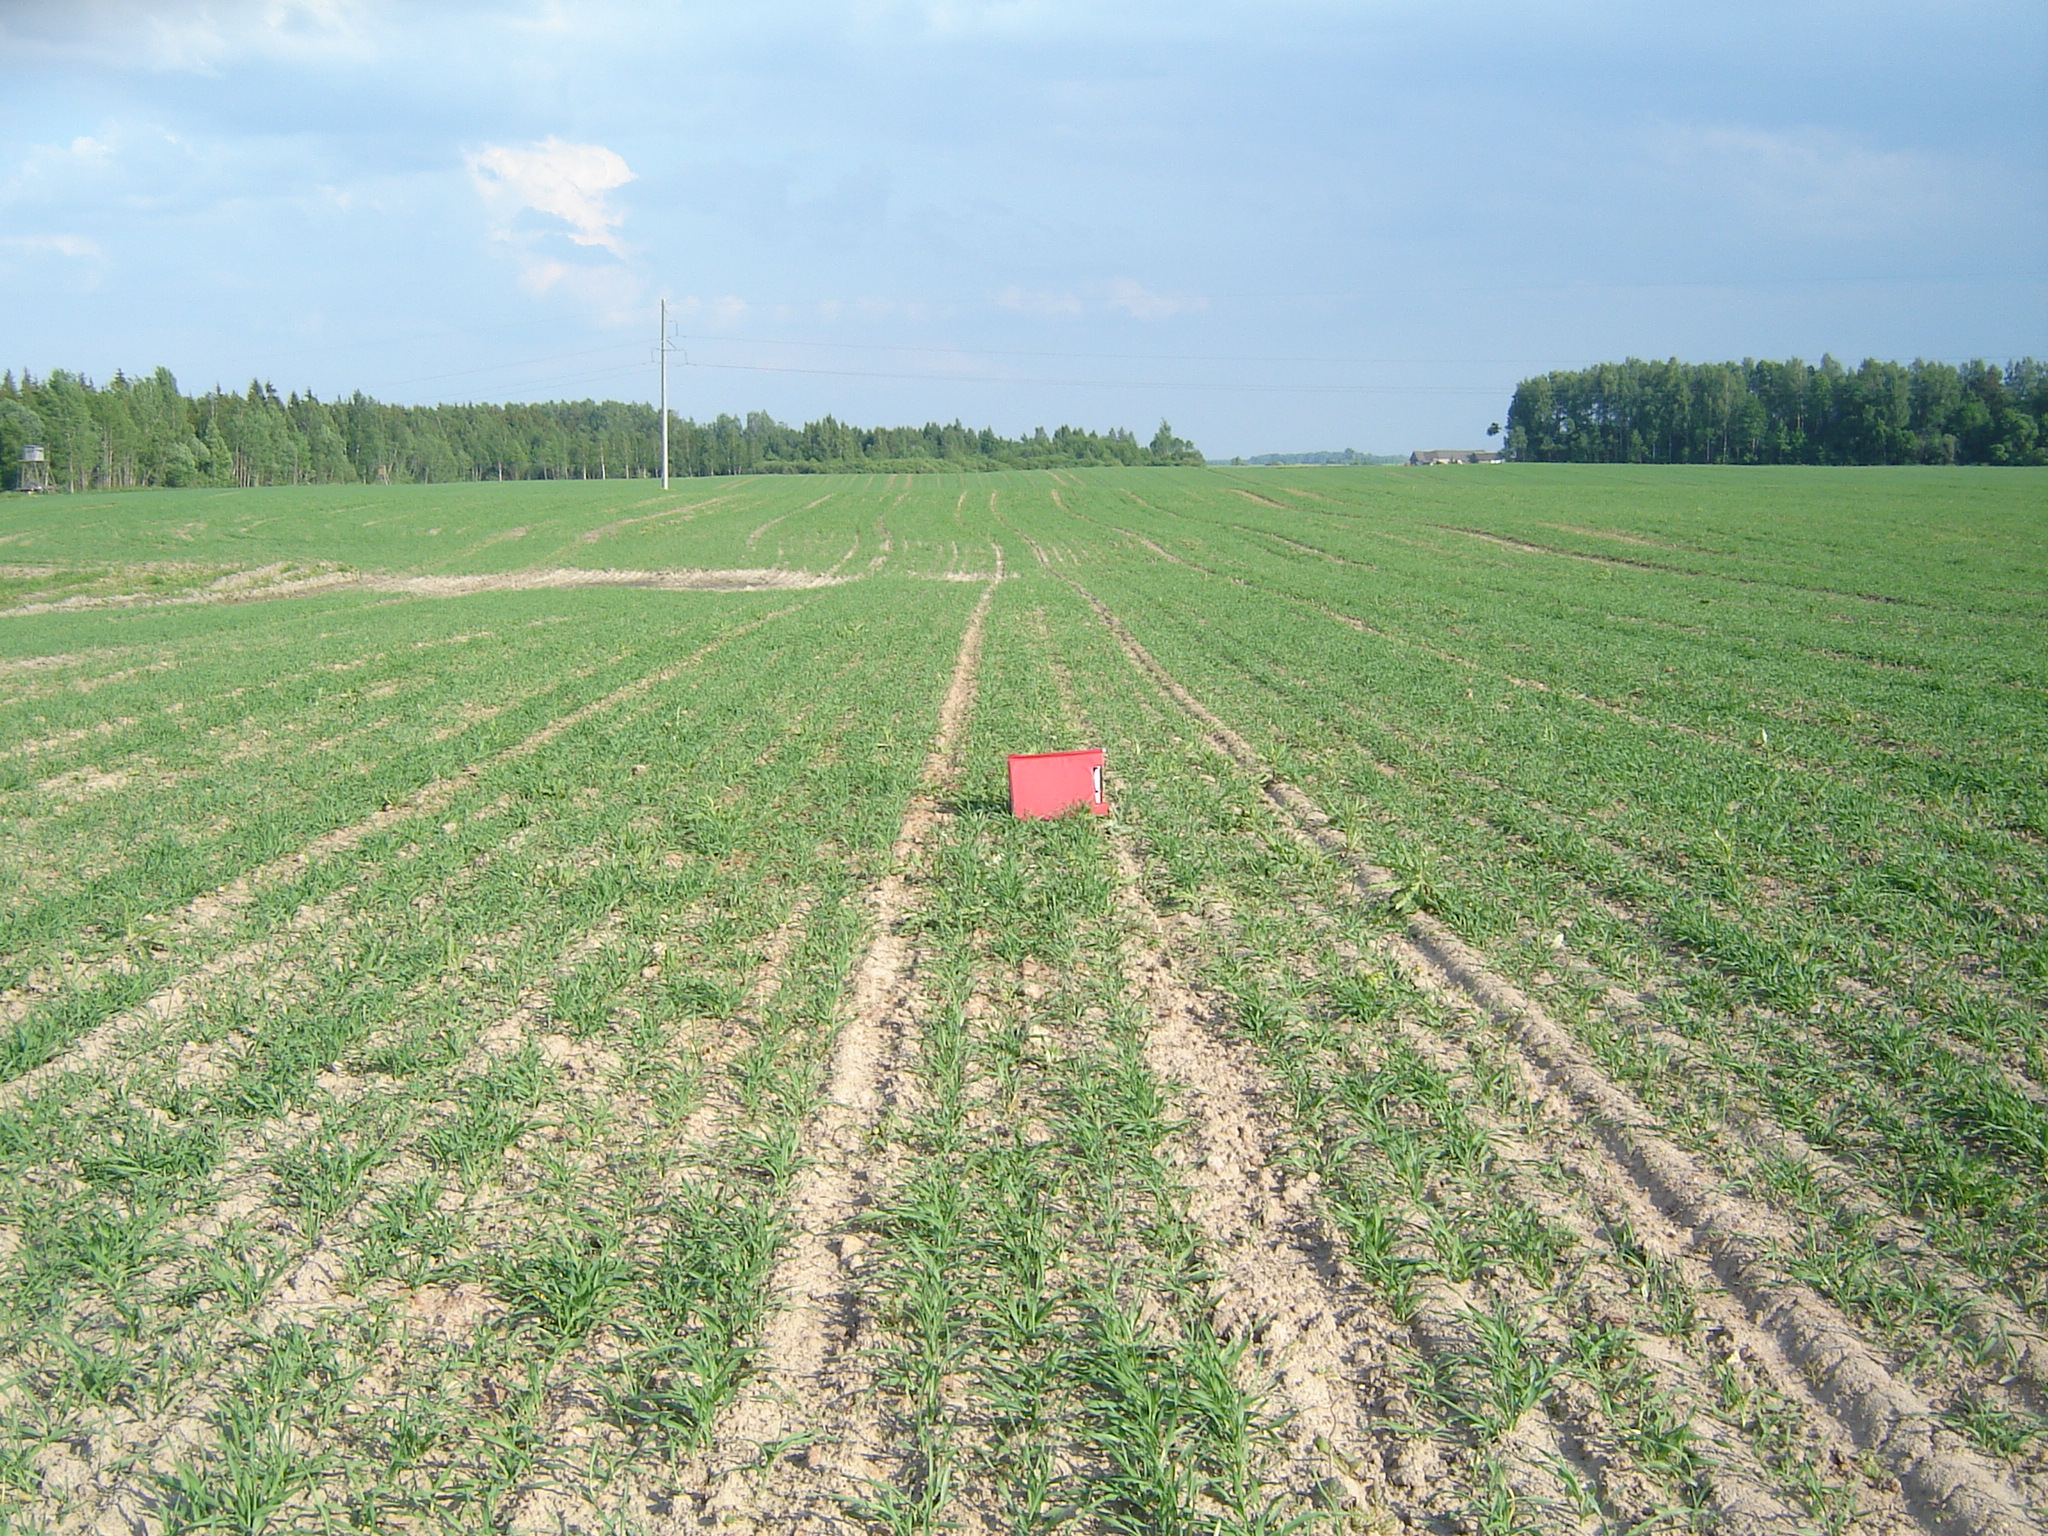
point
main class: Cropland
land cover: Barley
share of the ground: 50 - 75 %
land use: Agriculture (excluding fallow land and kitchen gardens)
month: June
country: LT
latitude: 55.8733
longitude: 25.2519
